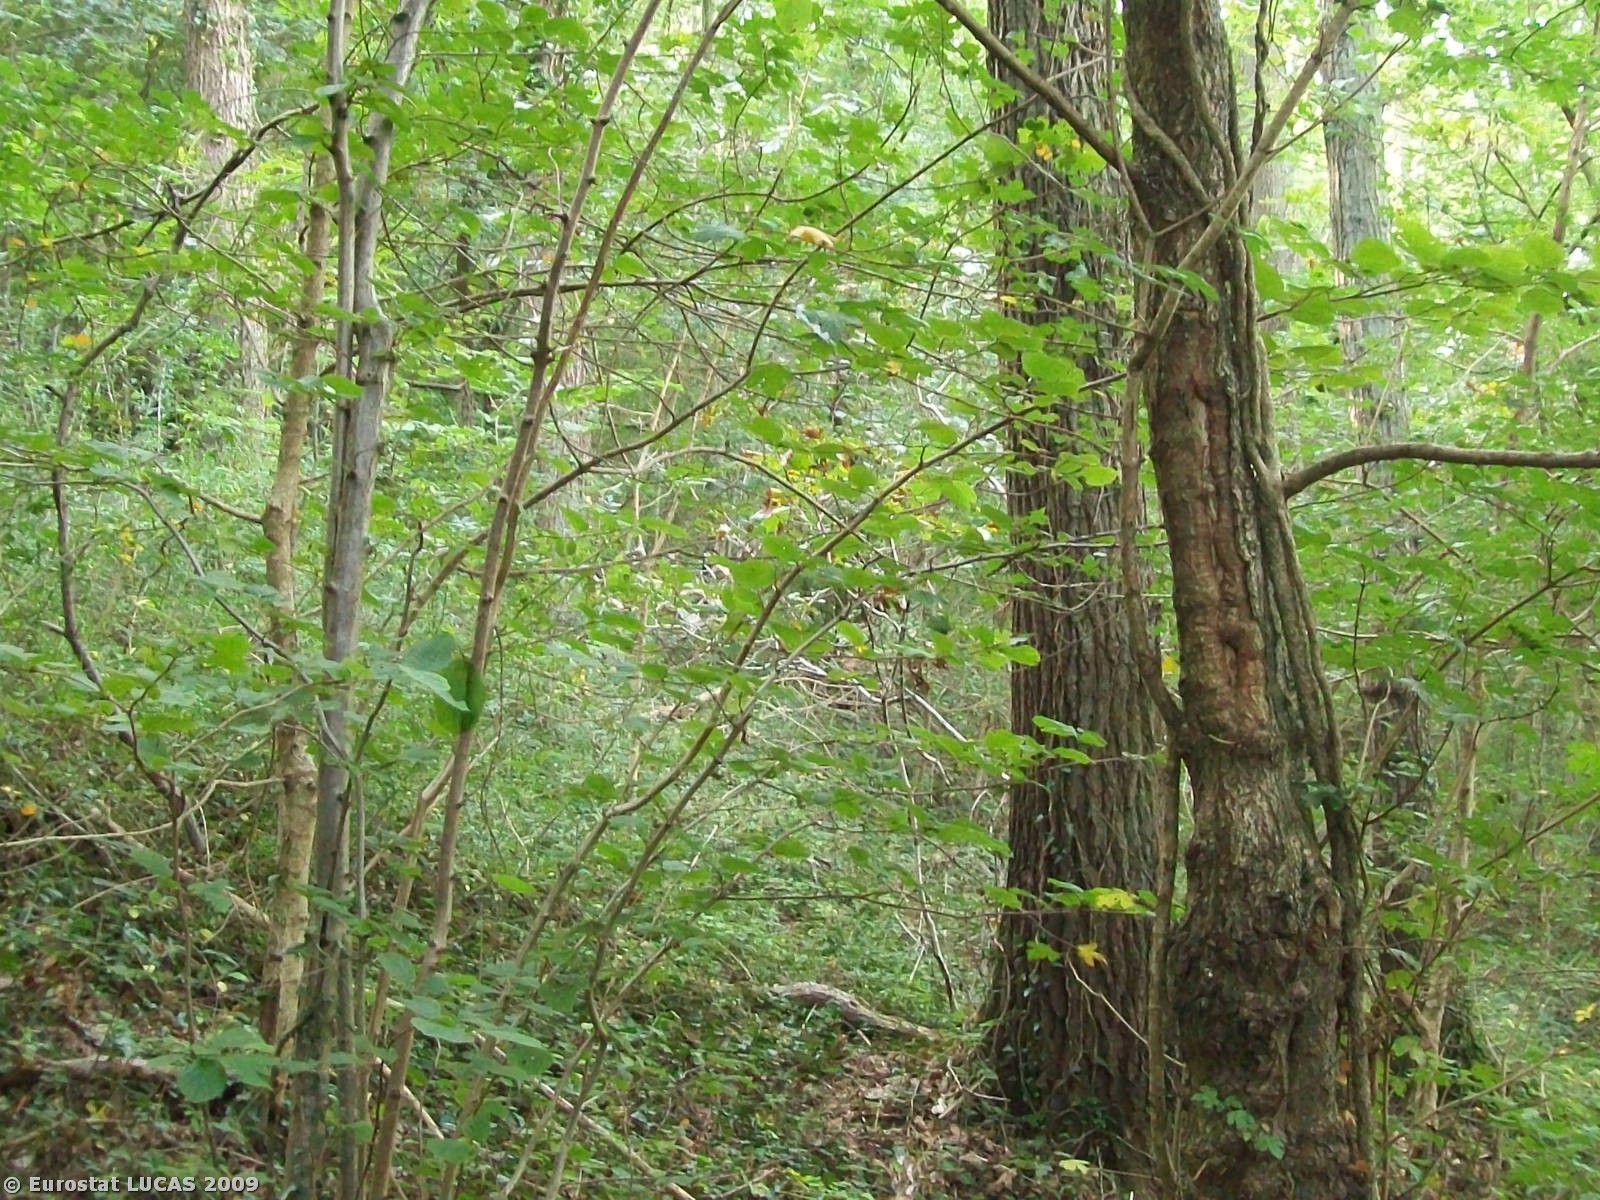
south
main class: Woodland
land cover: Broadleaved woodland
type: mesophytic deciduous forest
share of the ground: > 75 %
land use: Community services
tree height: > 5 m
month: September
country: GB
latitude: 52.1445
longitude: -2.3833
